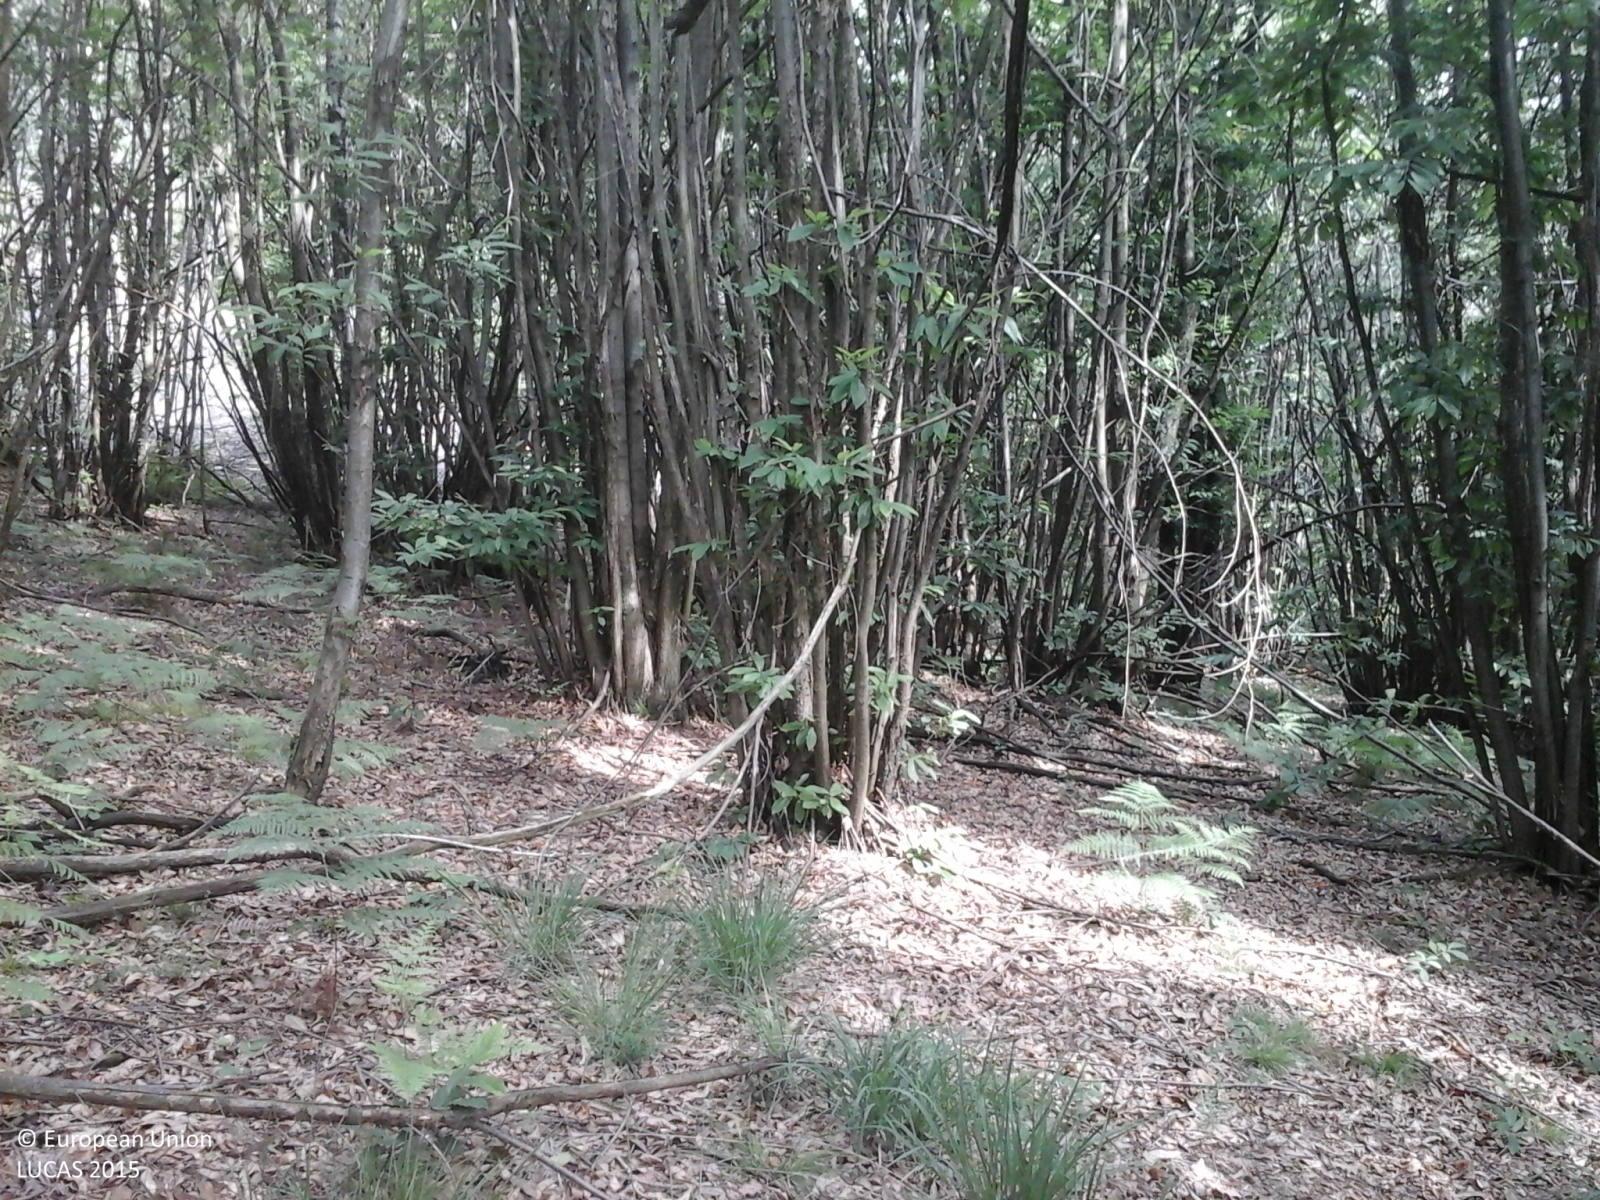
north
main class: Woodland
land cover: Broadleaved woodland
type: thermophilous deciduous forest
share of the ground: > 75 %
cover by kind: broadleaved forest trees 100 %
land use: Forestry
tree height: > 5 m
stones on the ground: < 10 %
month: June
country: IT
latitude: 45.4849
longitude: 7.9690
